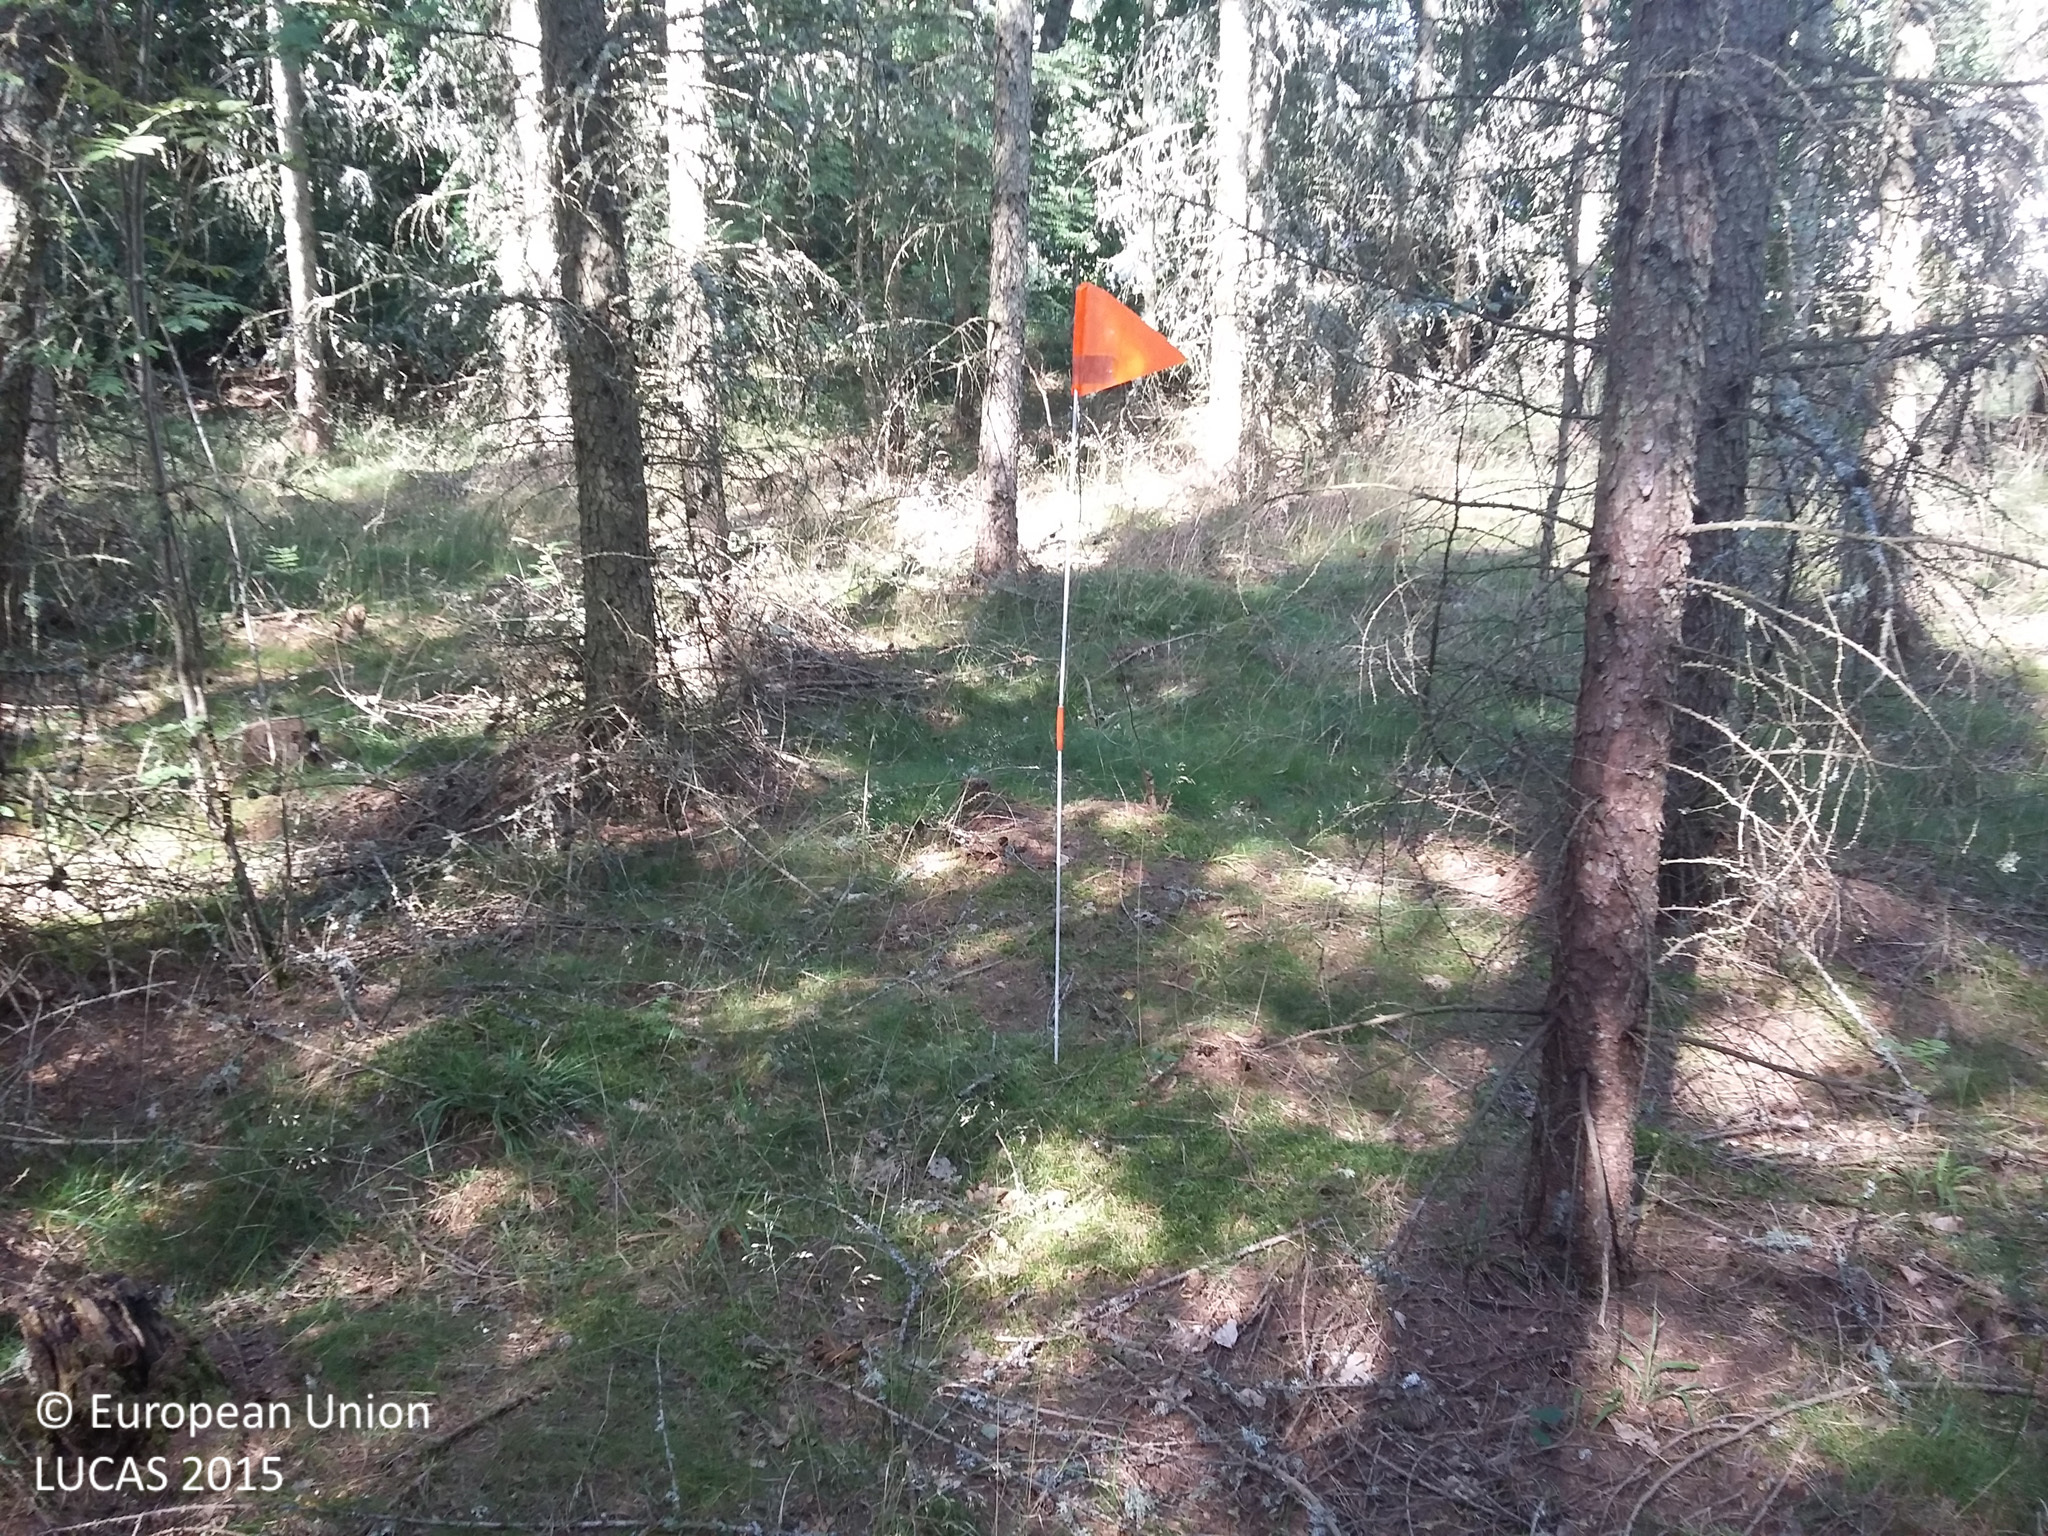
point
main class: Woodland
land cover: Pine dominated coniferous woodland
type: alpine coniferous forest
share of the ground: > 75 %
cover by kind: coniferous forest trees 80 %, herbaceous plants 10 %, lichens and mosses 10 %
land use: Forestry
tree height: > 5 m
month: July
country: DK
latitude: 56.0447
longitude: 12.1009
